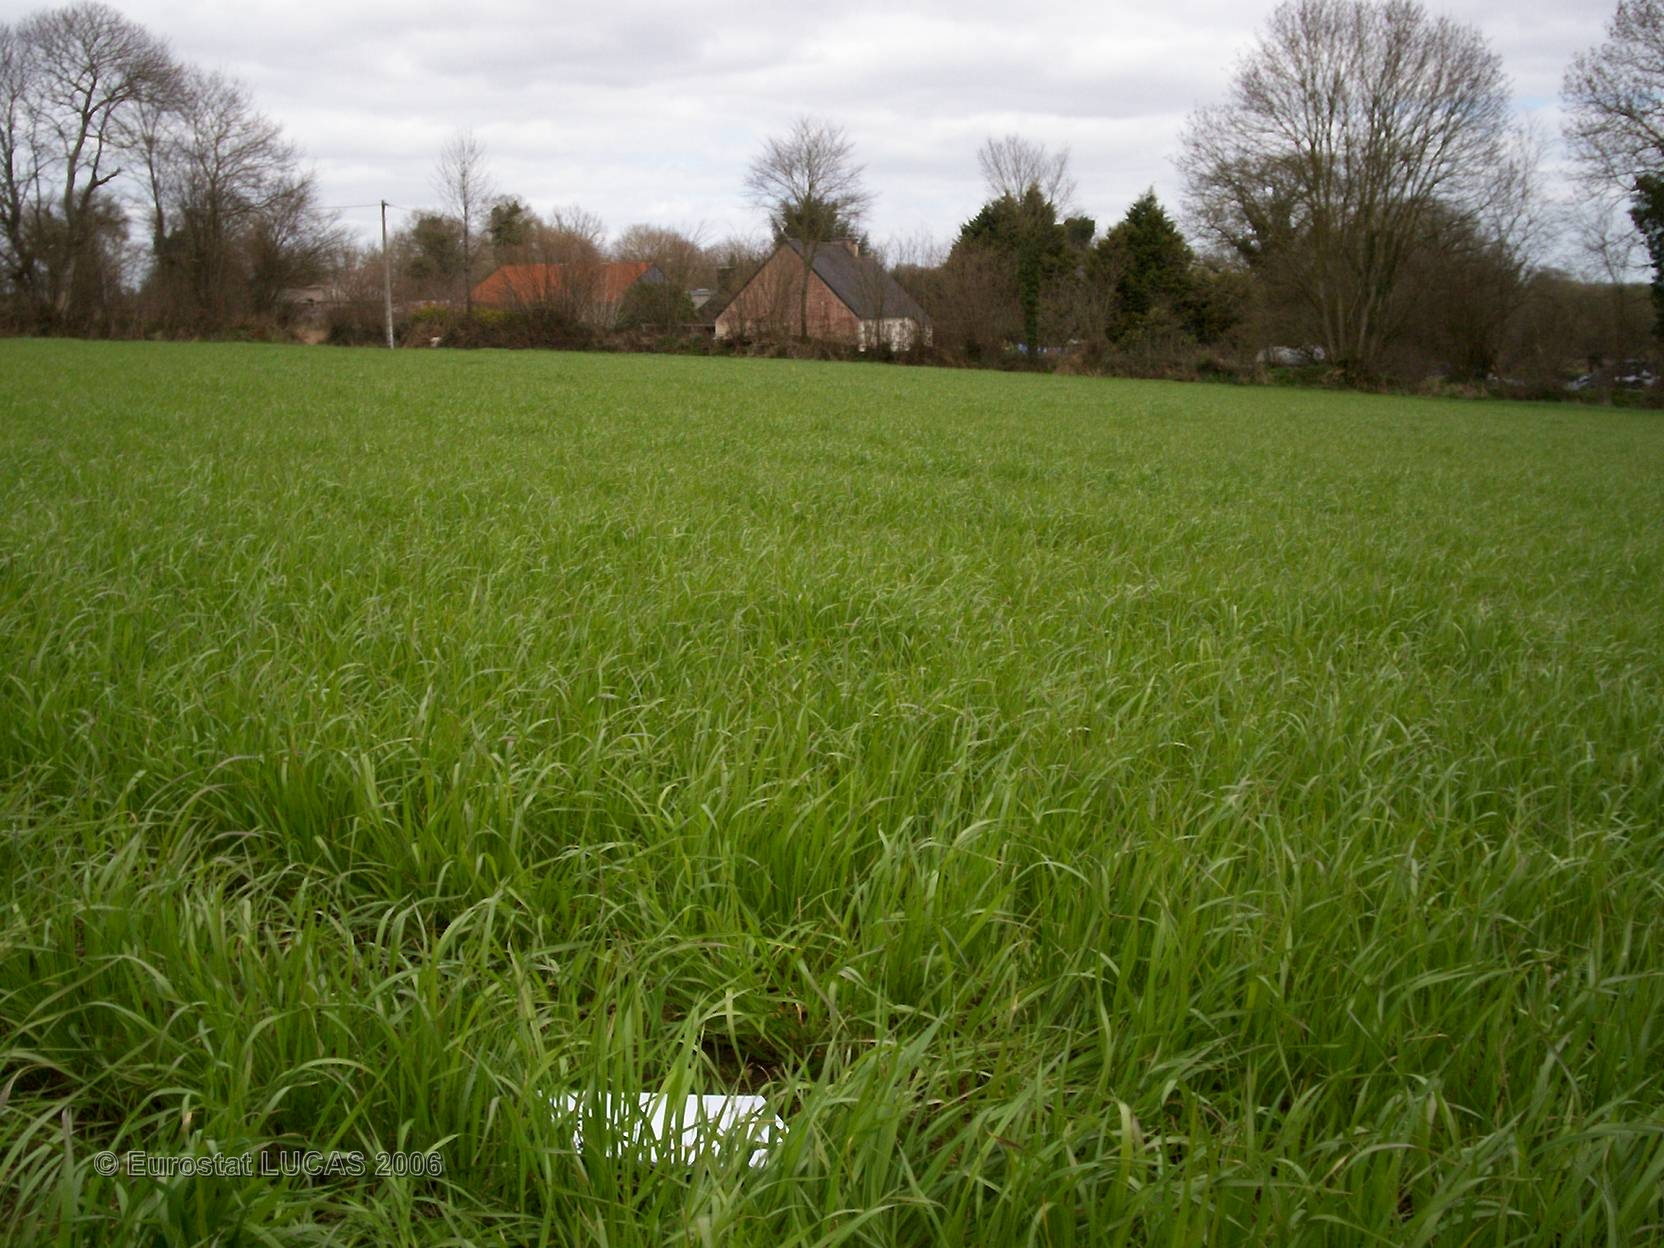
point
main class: Grassland
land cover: Grassland without tree/shrub cover
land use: Agriculture (excluding fallow land and kitchen gardens)
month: April
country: FR
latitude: 48.2145
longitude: -3.6053
